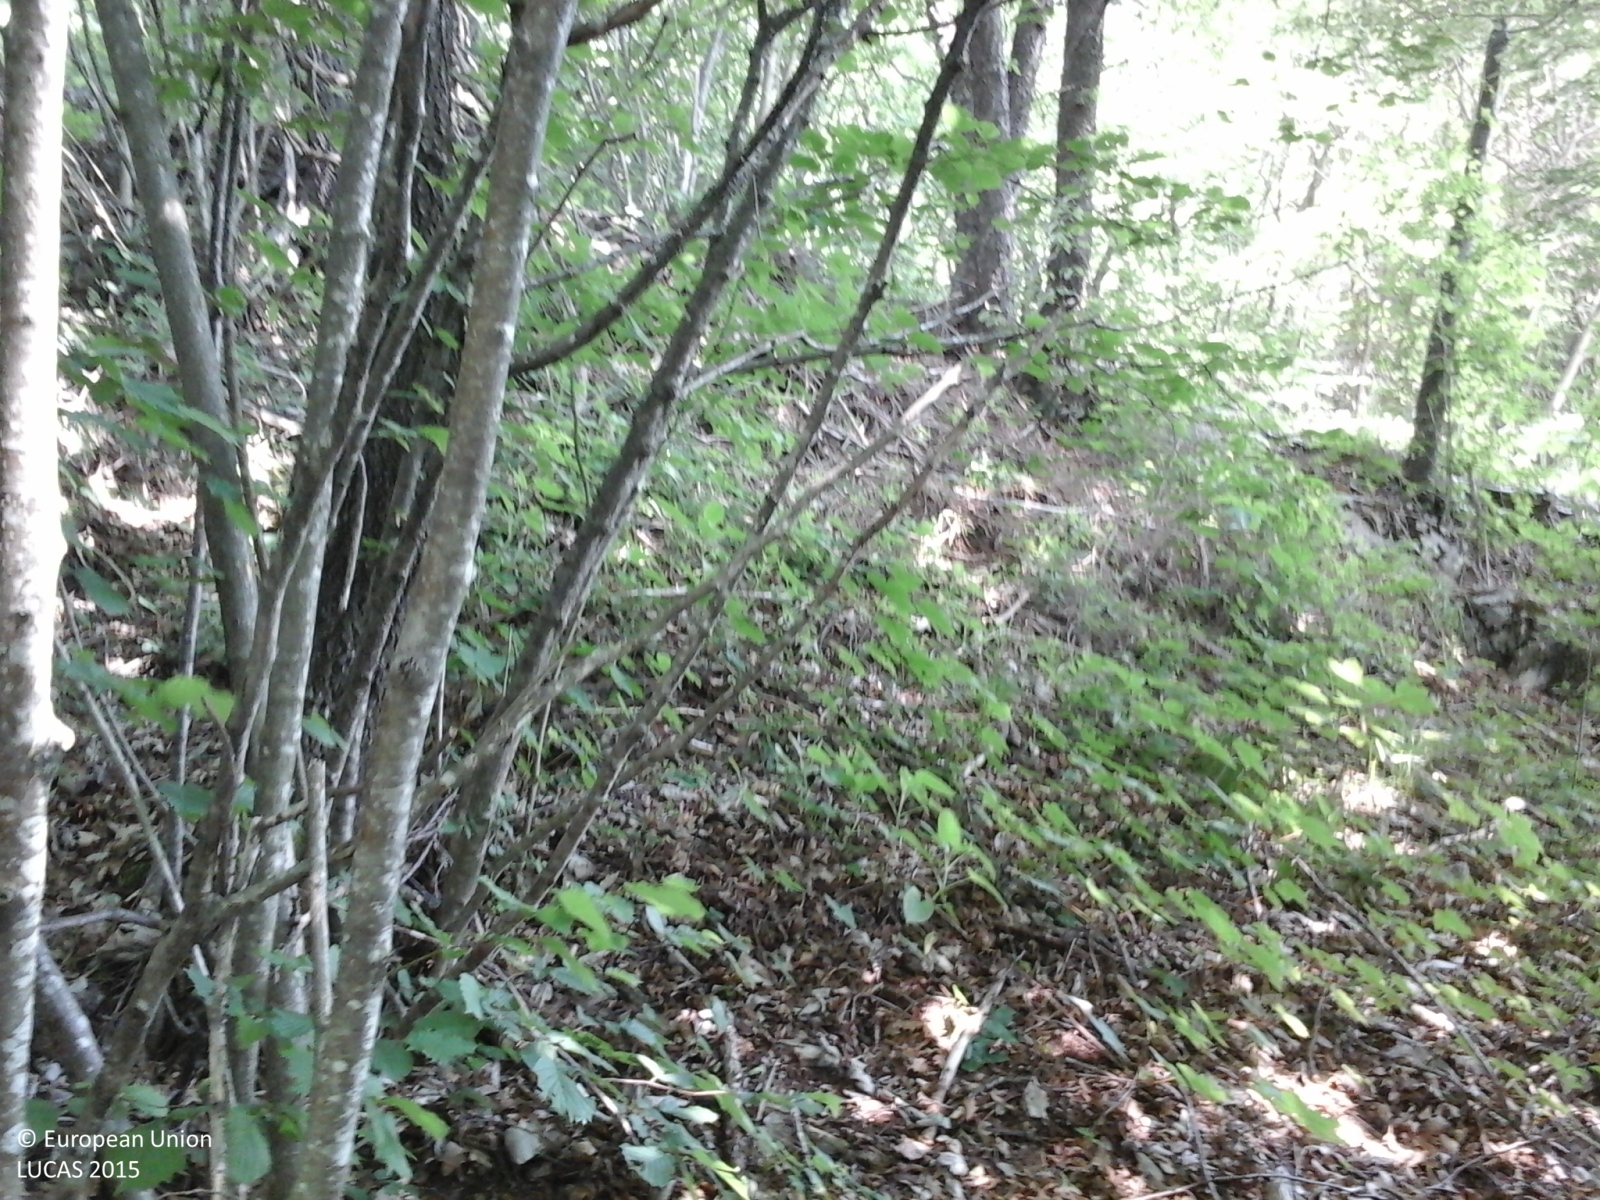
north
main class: Woodland
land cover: Broadleaved woodland
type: thermophilous deciduous forest
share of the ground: > 75 %
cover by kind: broadleaved forest trees 100 %
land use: Forestry
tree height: > 5 m
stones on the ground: 10 - 25 %
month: June
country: IT
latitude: 45.7195
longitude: 10.5002
